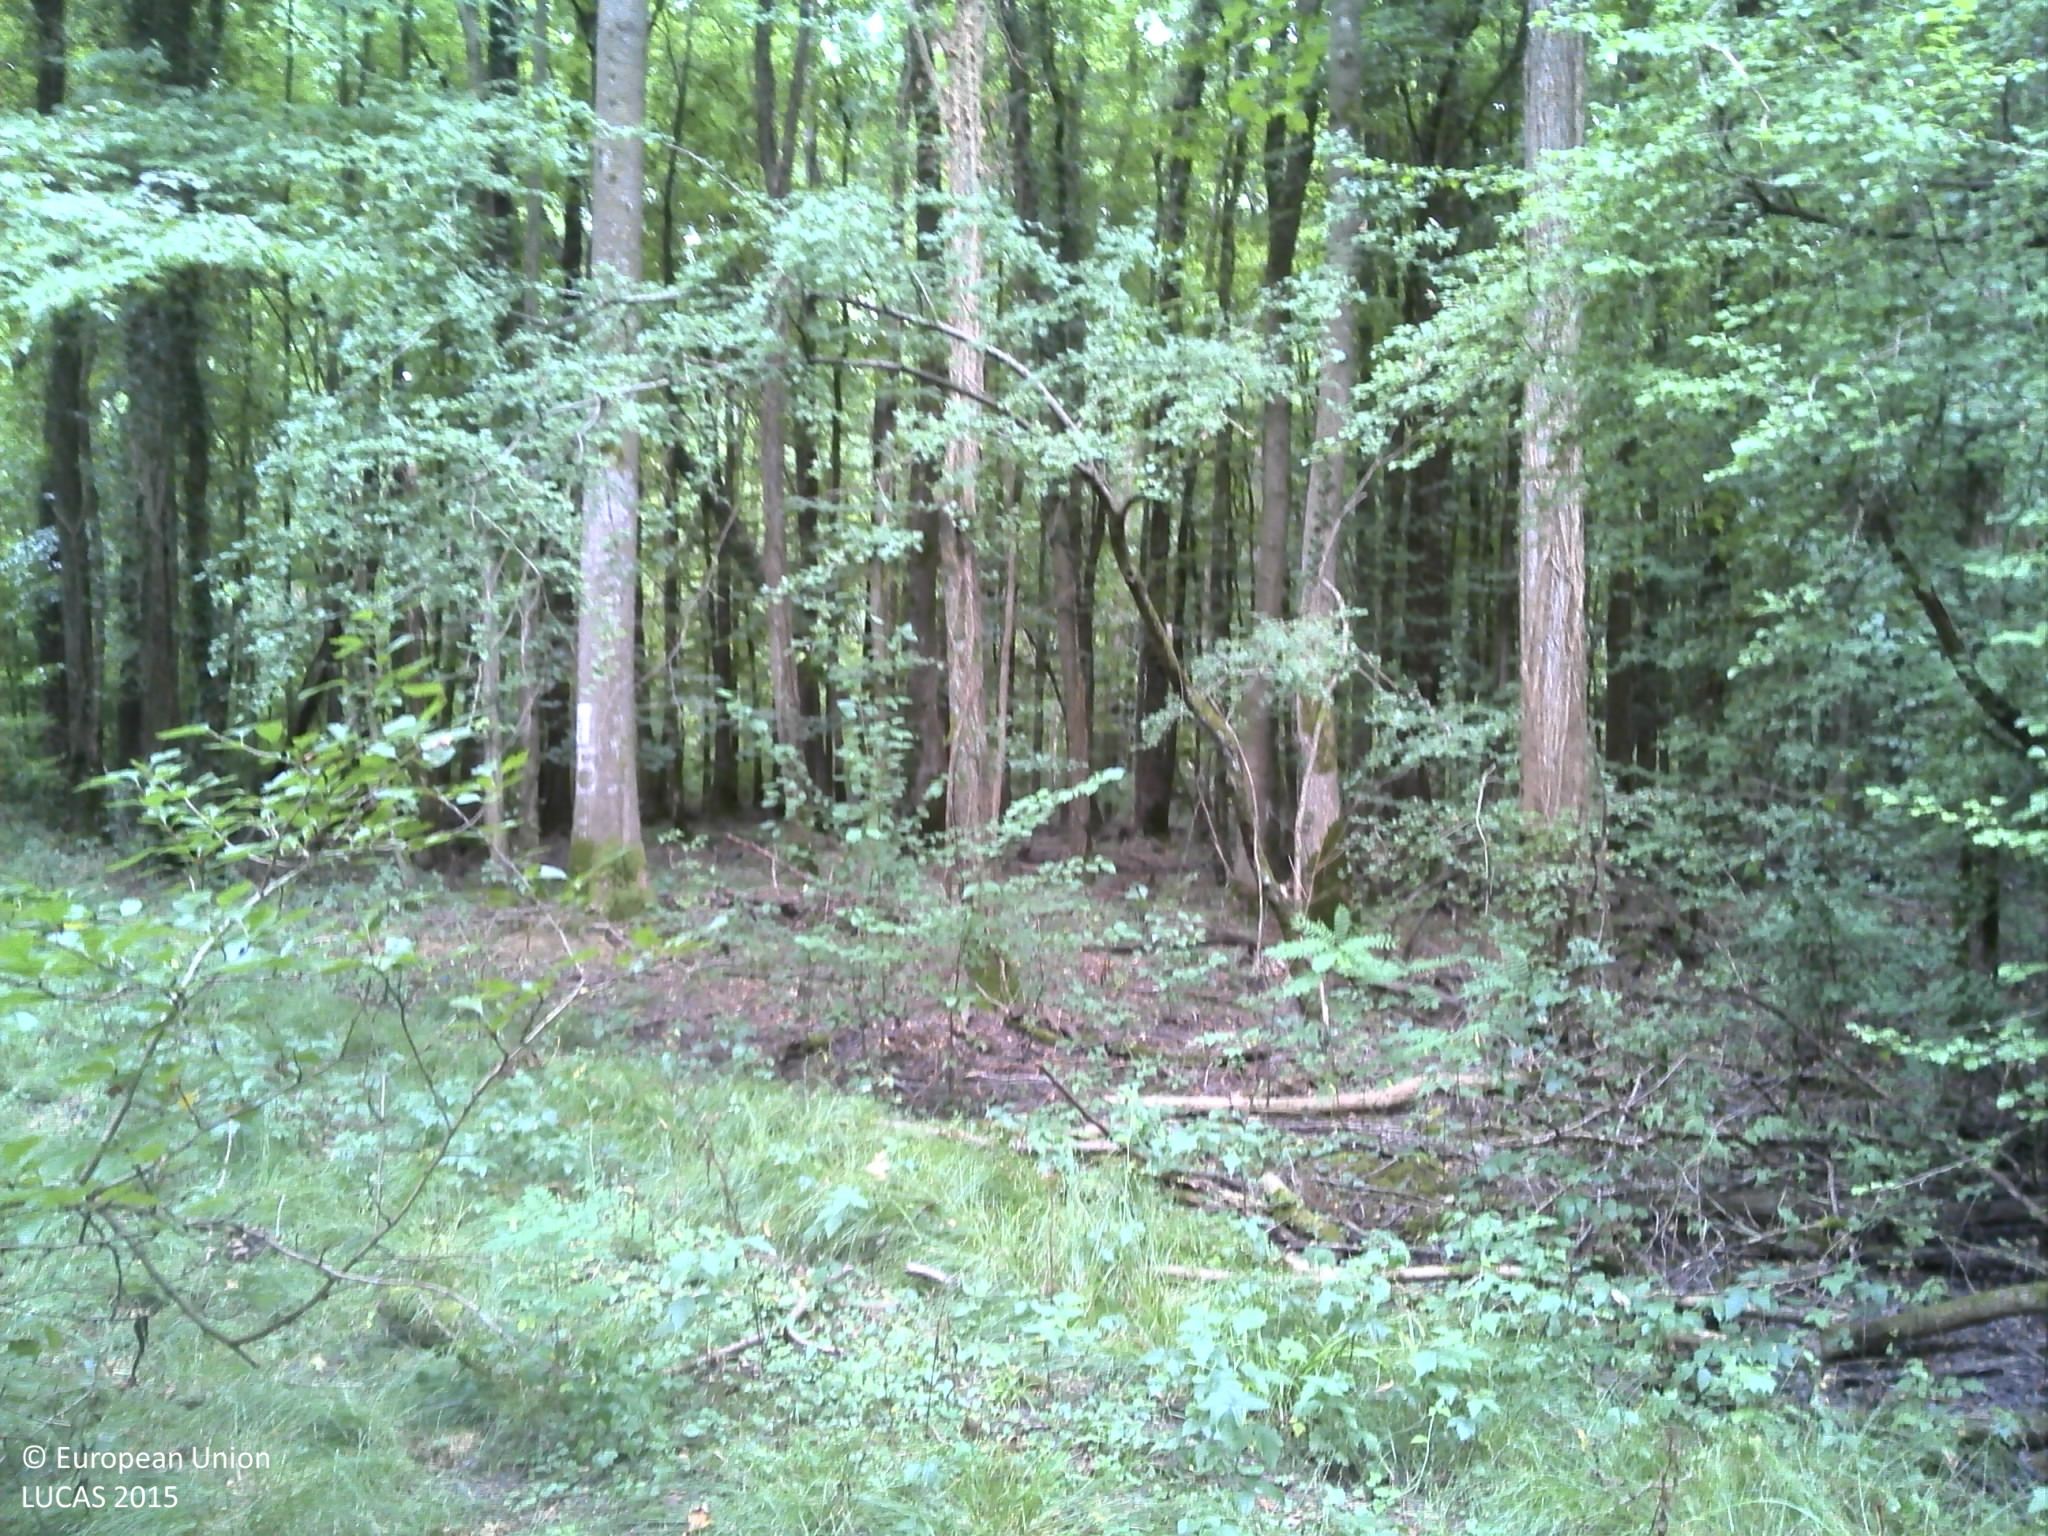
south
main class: Woodland
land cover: Broadleaved woodland
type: mesophytic deciduous forest
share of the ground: > 75 %
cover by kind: broadleaved forest trees 100 %
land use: Forestry
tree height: > 5 m
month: July
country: HR
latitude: 44.9359
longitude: 18.8125
